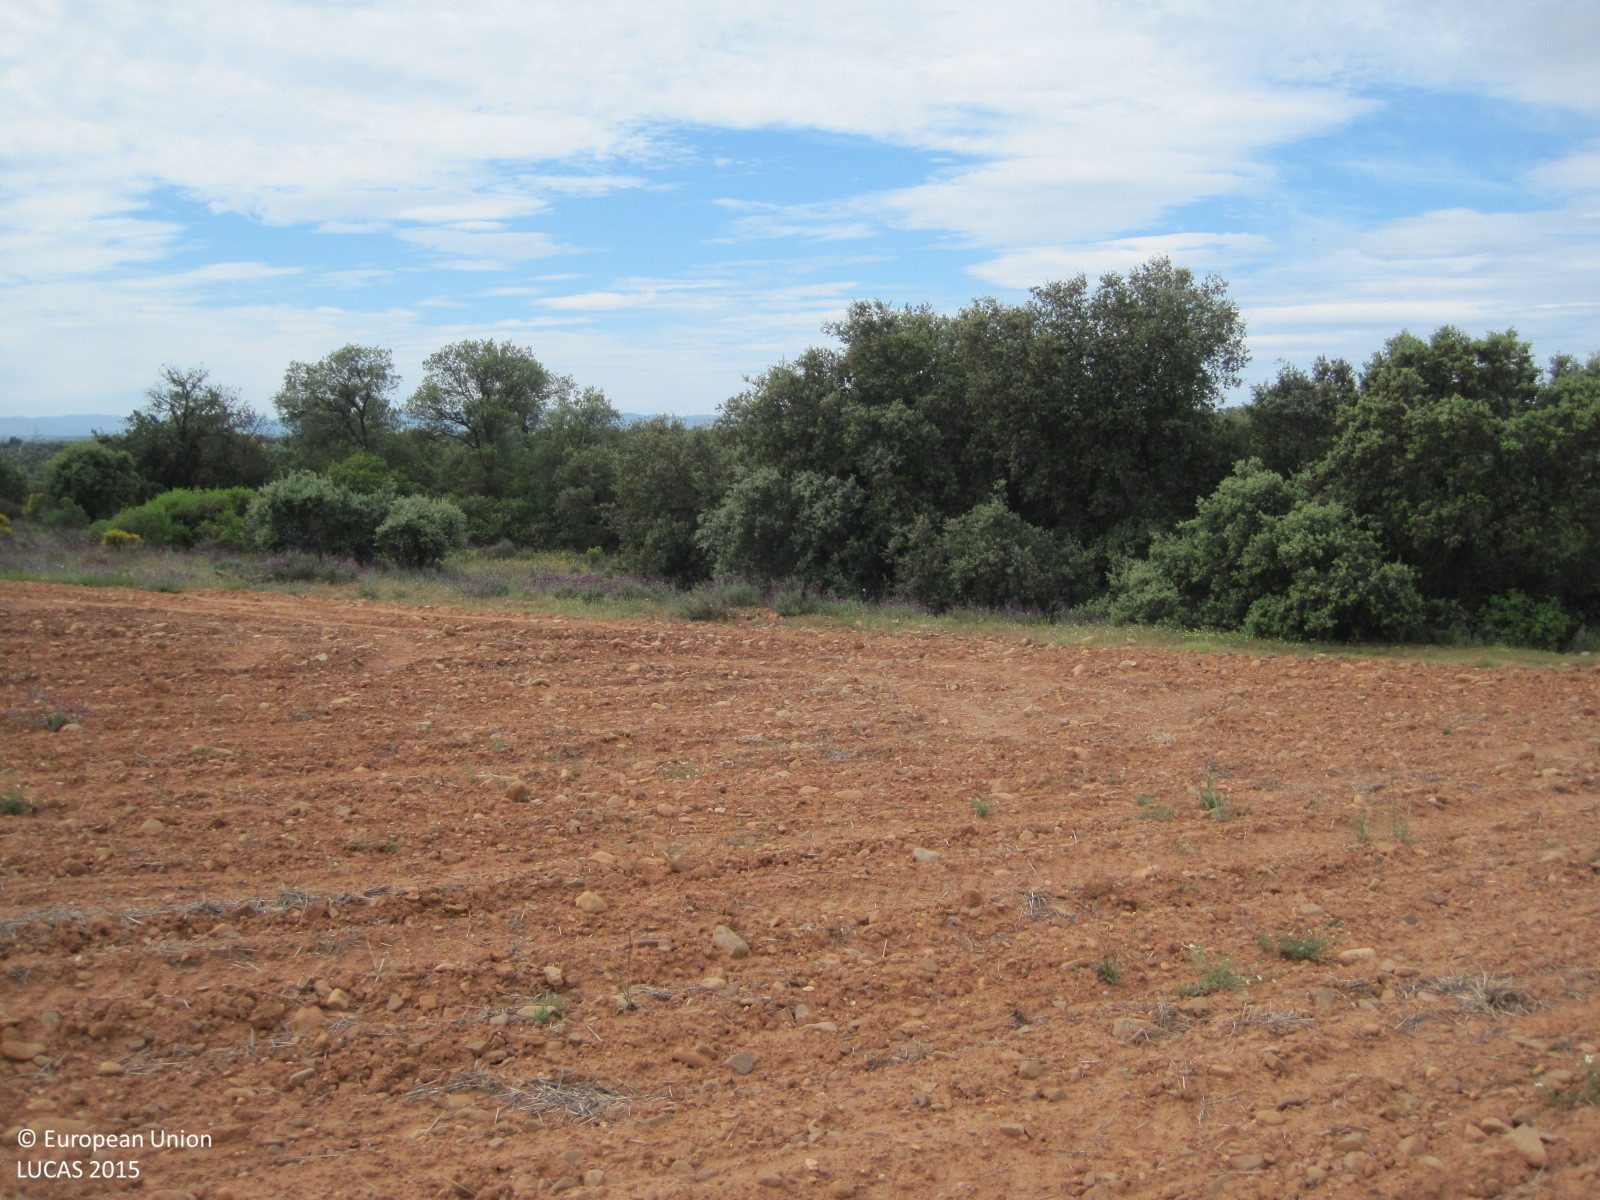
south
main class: Cropland
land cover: Sunflower
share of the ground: < 10 %
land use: Agriculture (excluding fallow land and kitchen gardens)
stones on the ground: 25 - 50 %
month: May
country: ES
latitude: 39.9164
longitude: -4.7515
